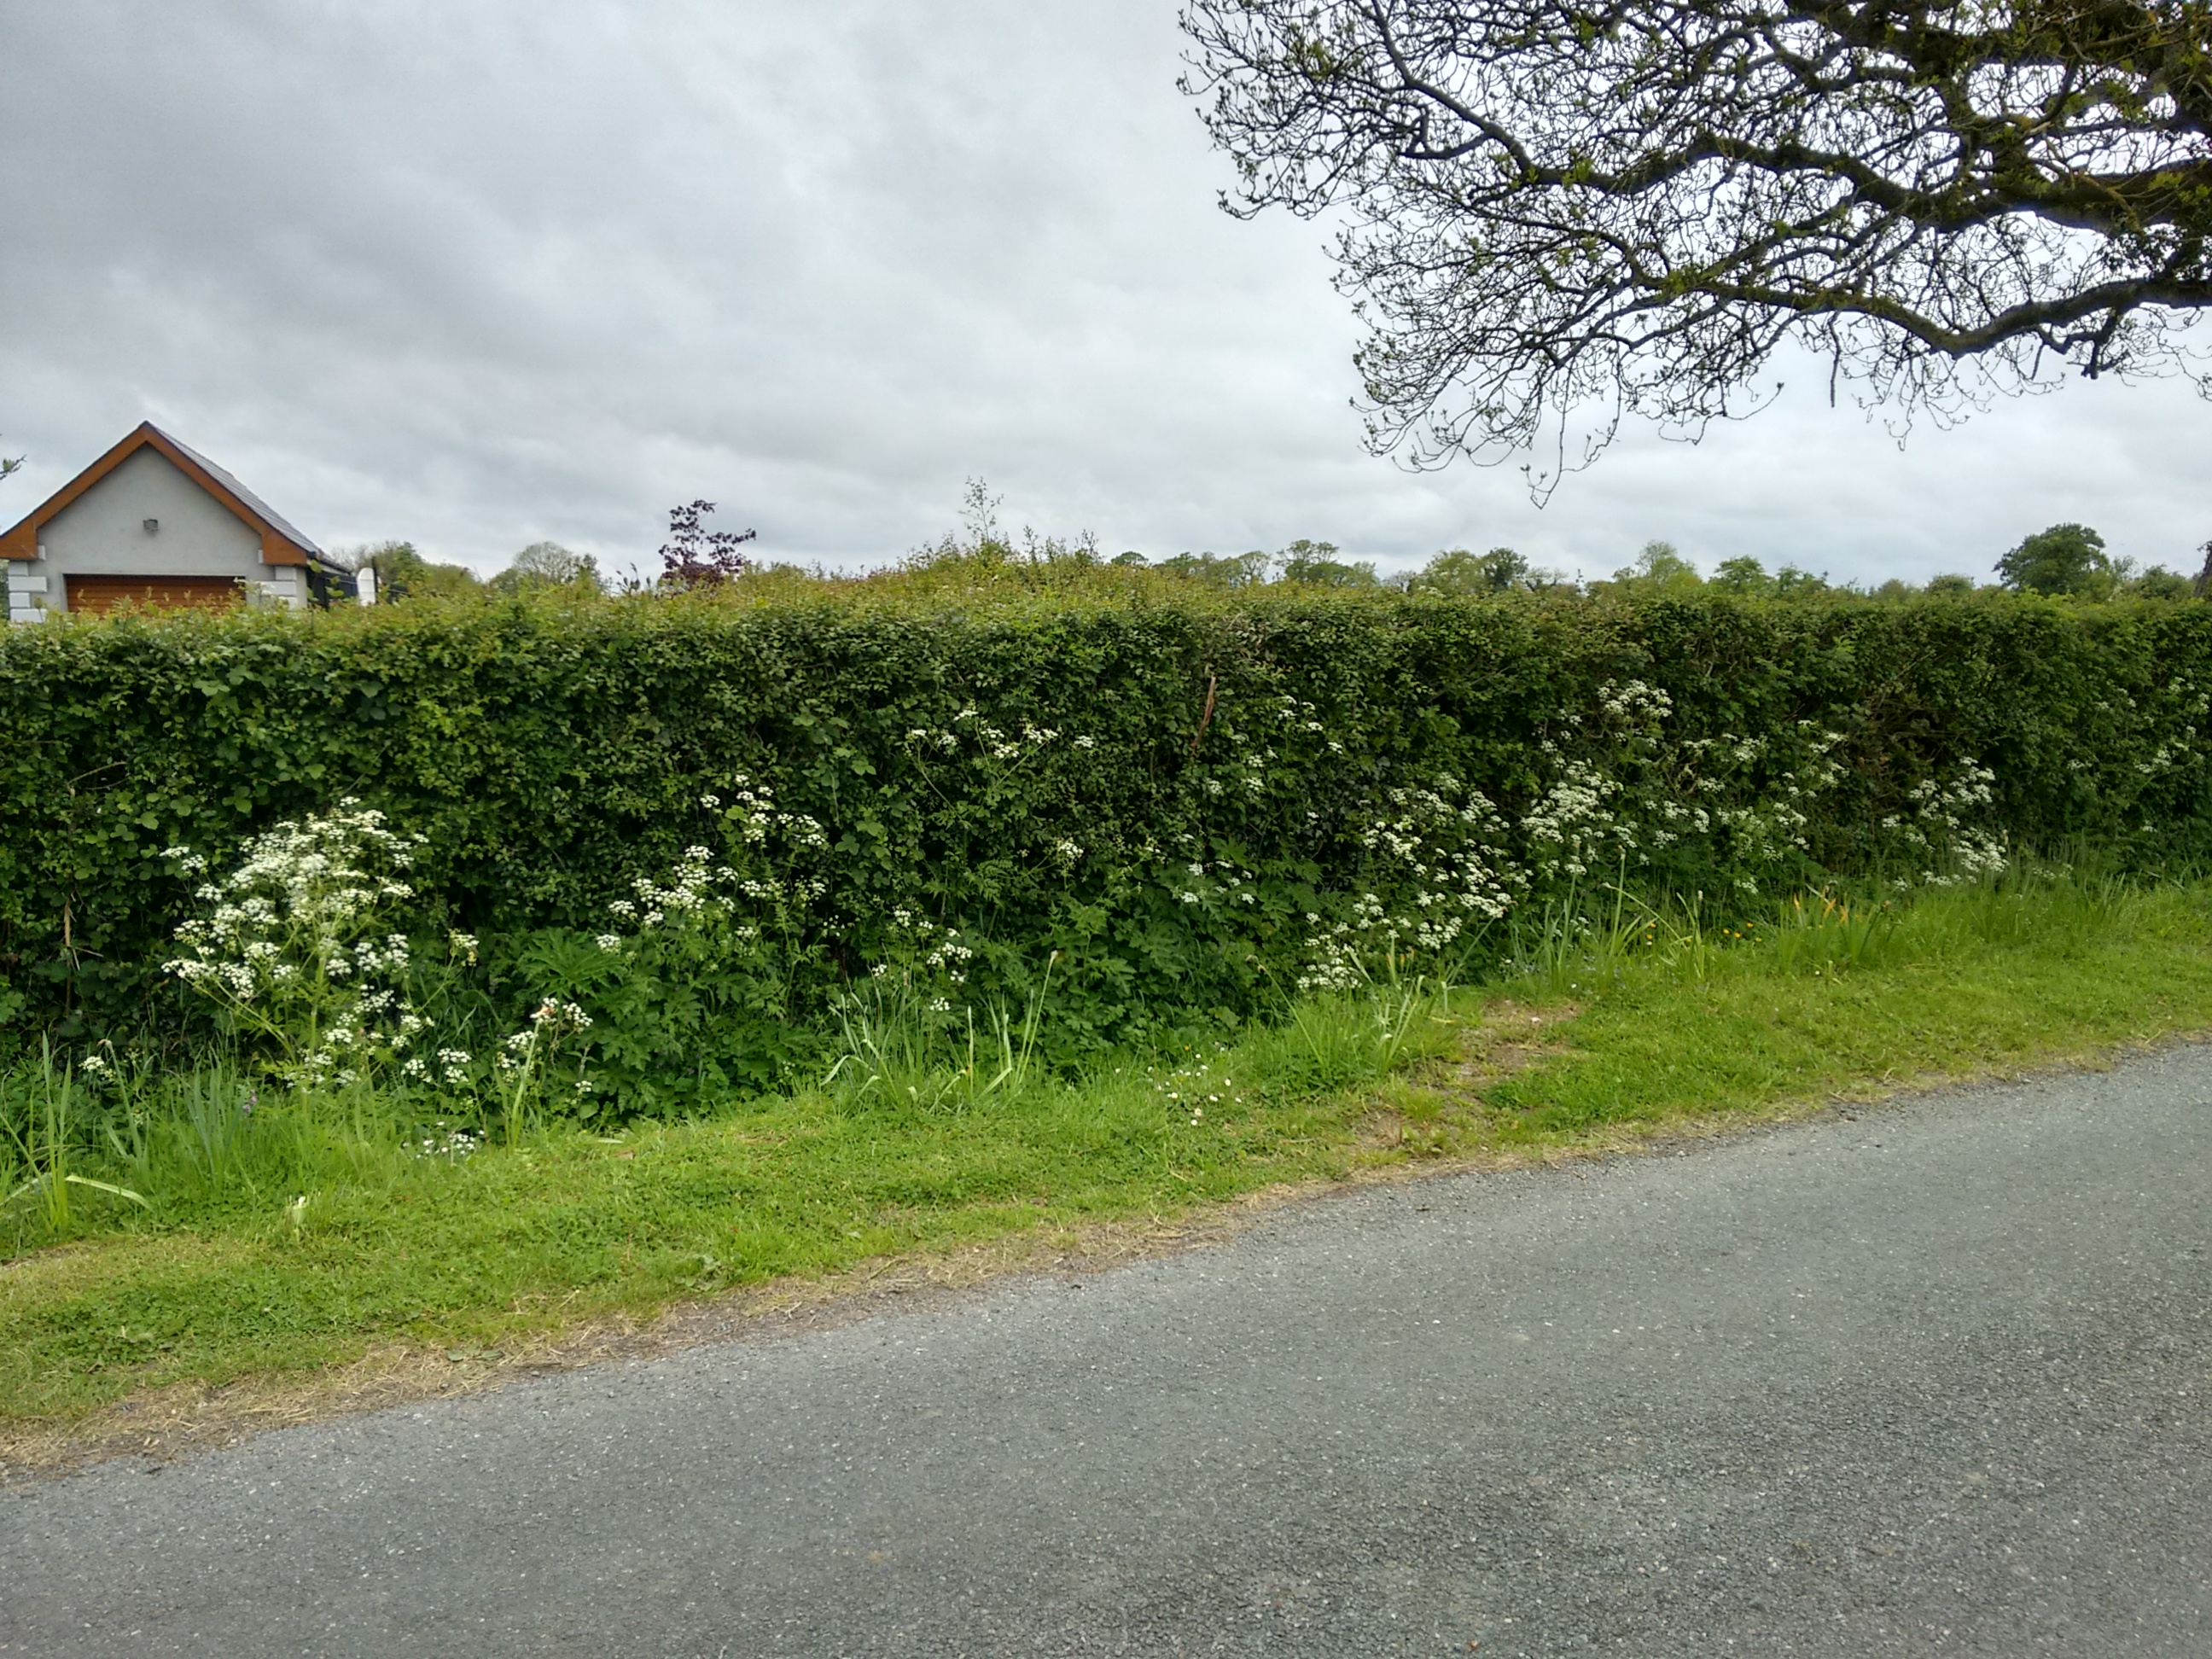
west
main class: Grassland
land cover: Grassland without tree/shrub cover
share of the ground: > 75 %
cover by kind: herbaceous plants 95 %, consolidated bare surface 5 %
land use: Agriculture (excluding fallow land and kitchen gardens)
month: May
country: IE
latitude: 53.4281
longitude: -6.5477
